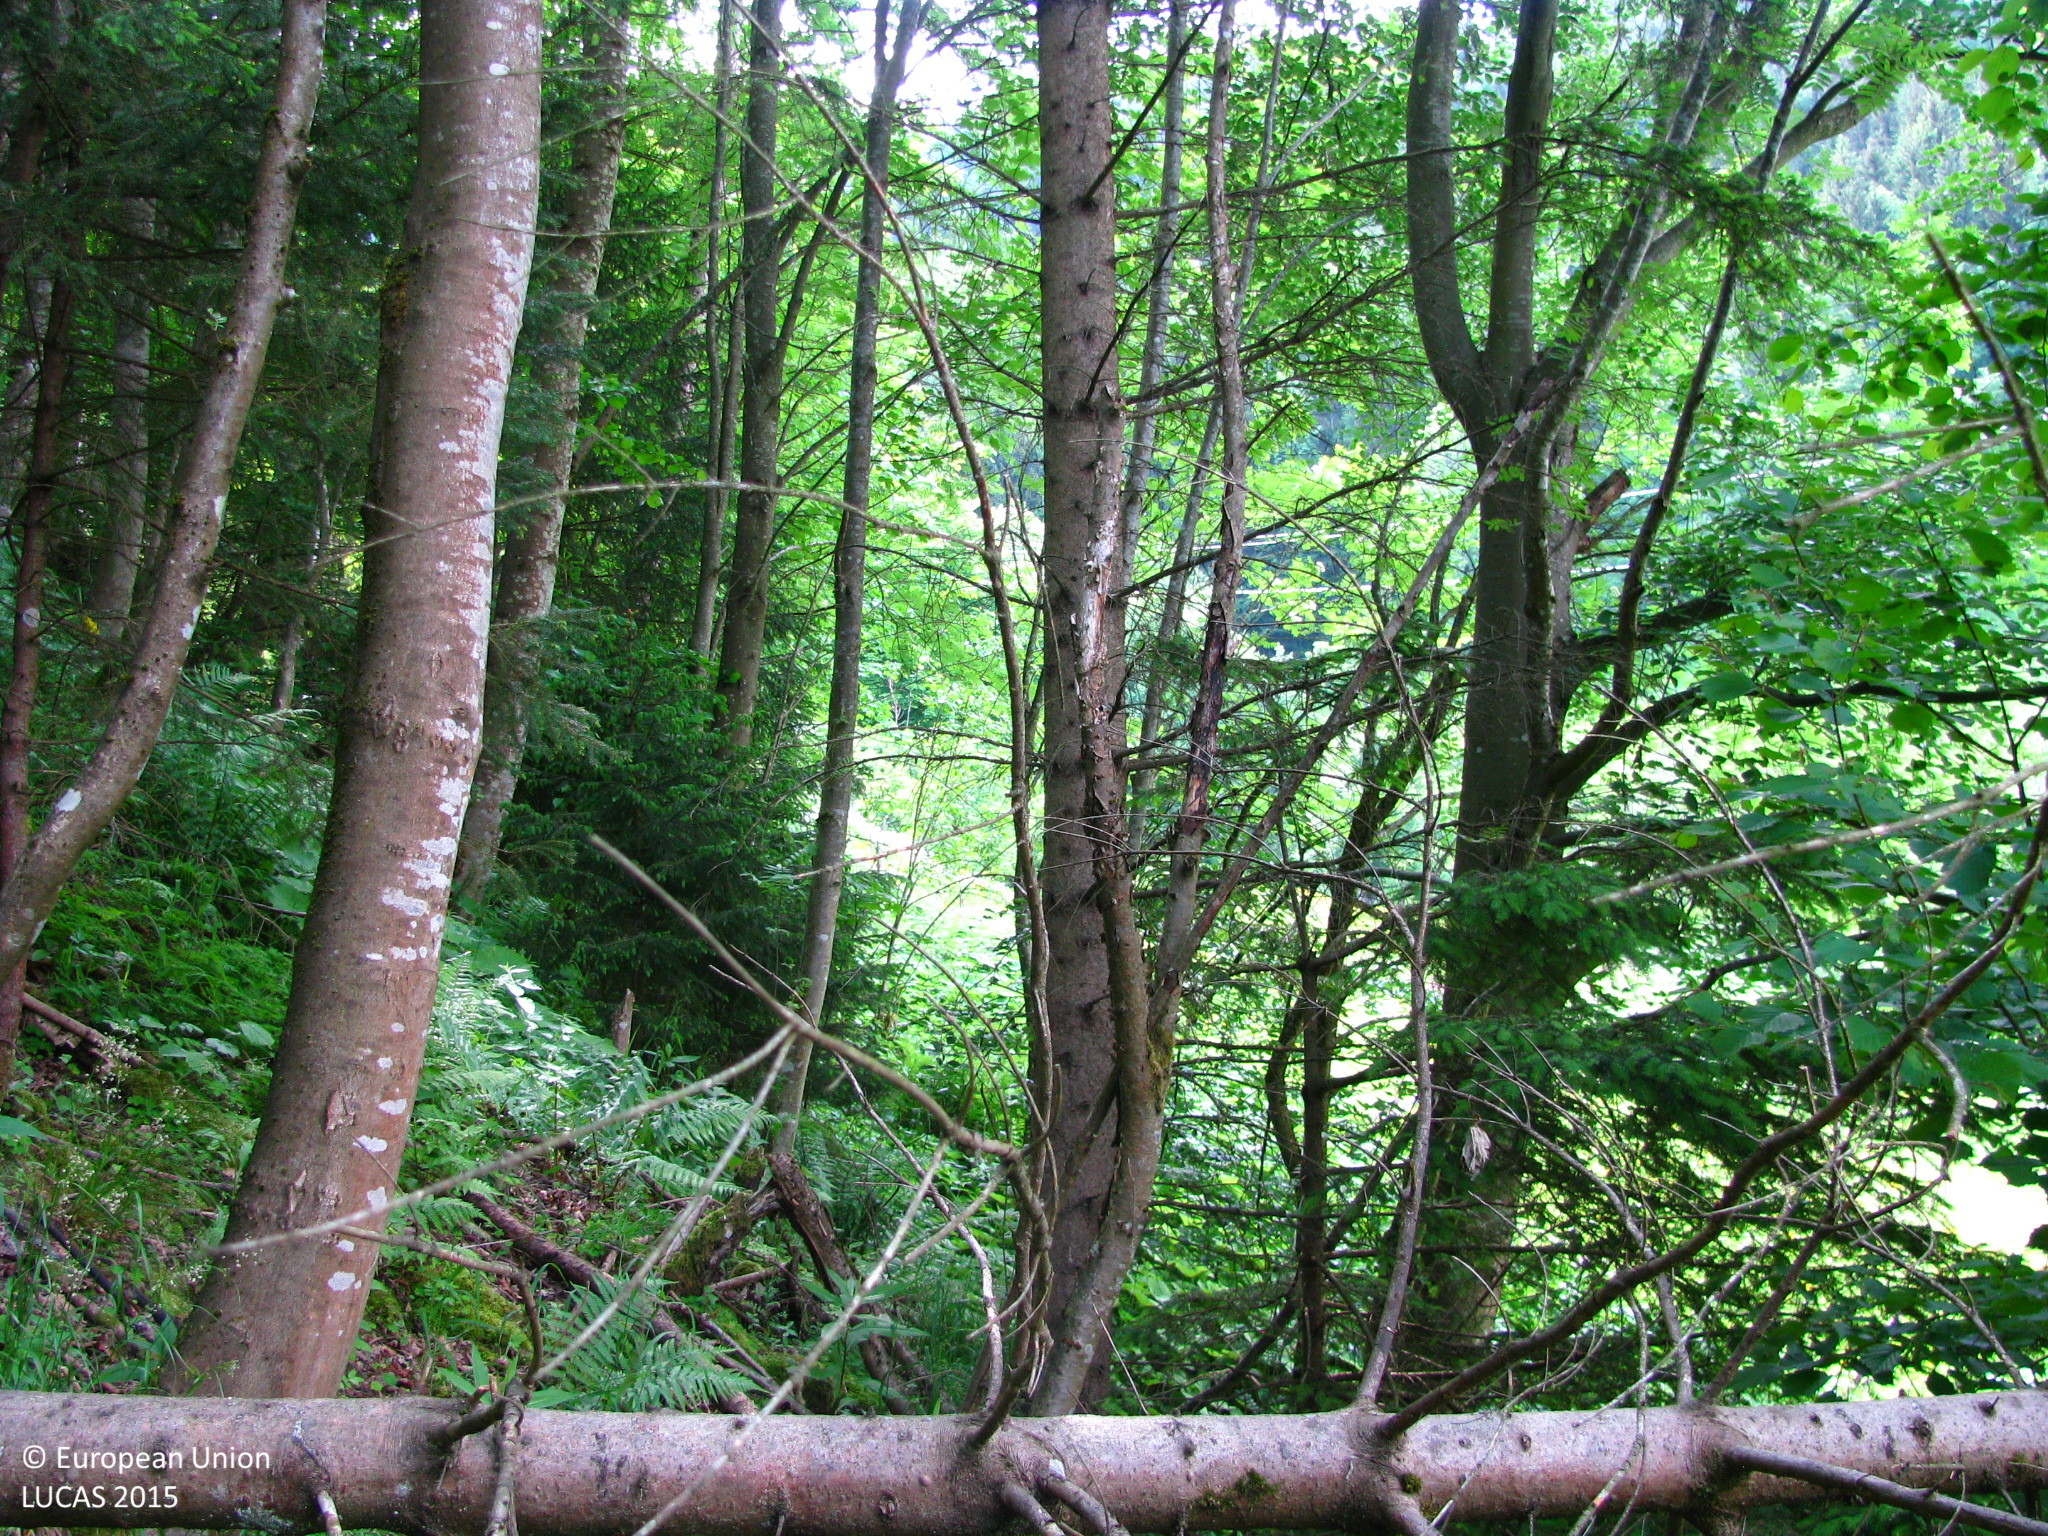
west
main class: Woodland
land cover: Spruce dominated mixed woodland
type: alpine coniferous forest
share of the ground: > 75 %
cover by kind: broadleaved forest trees 50 %, coniferous forest trees 30 %, herbaceous plants 15 %, lichens and mosses 5 %
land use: Forestry
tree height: > 5 m
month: June
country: AT
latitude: 47.4454
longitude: 14.9463
